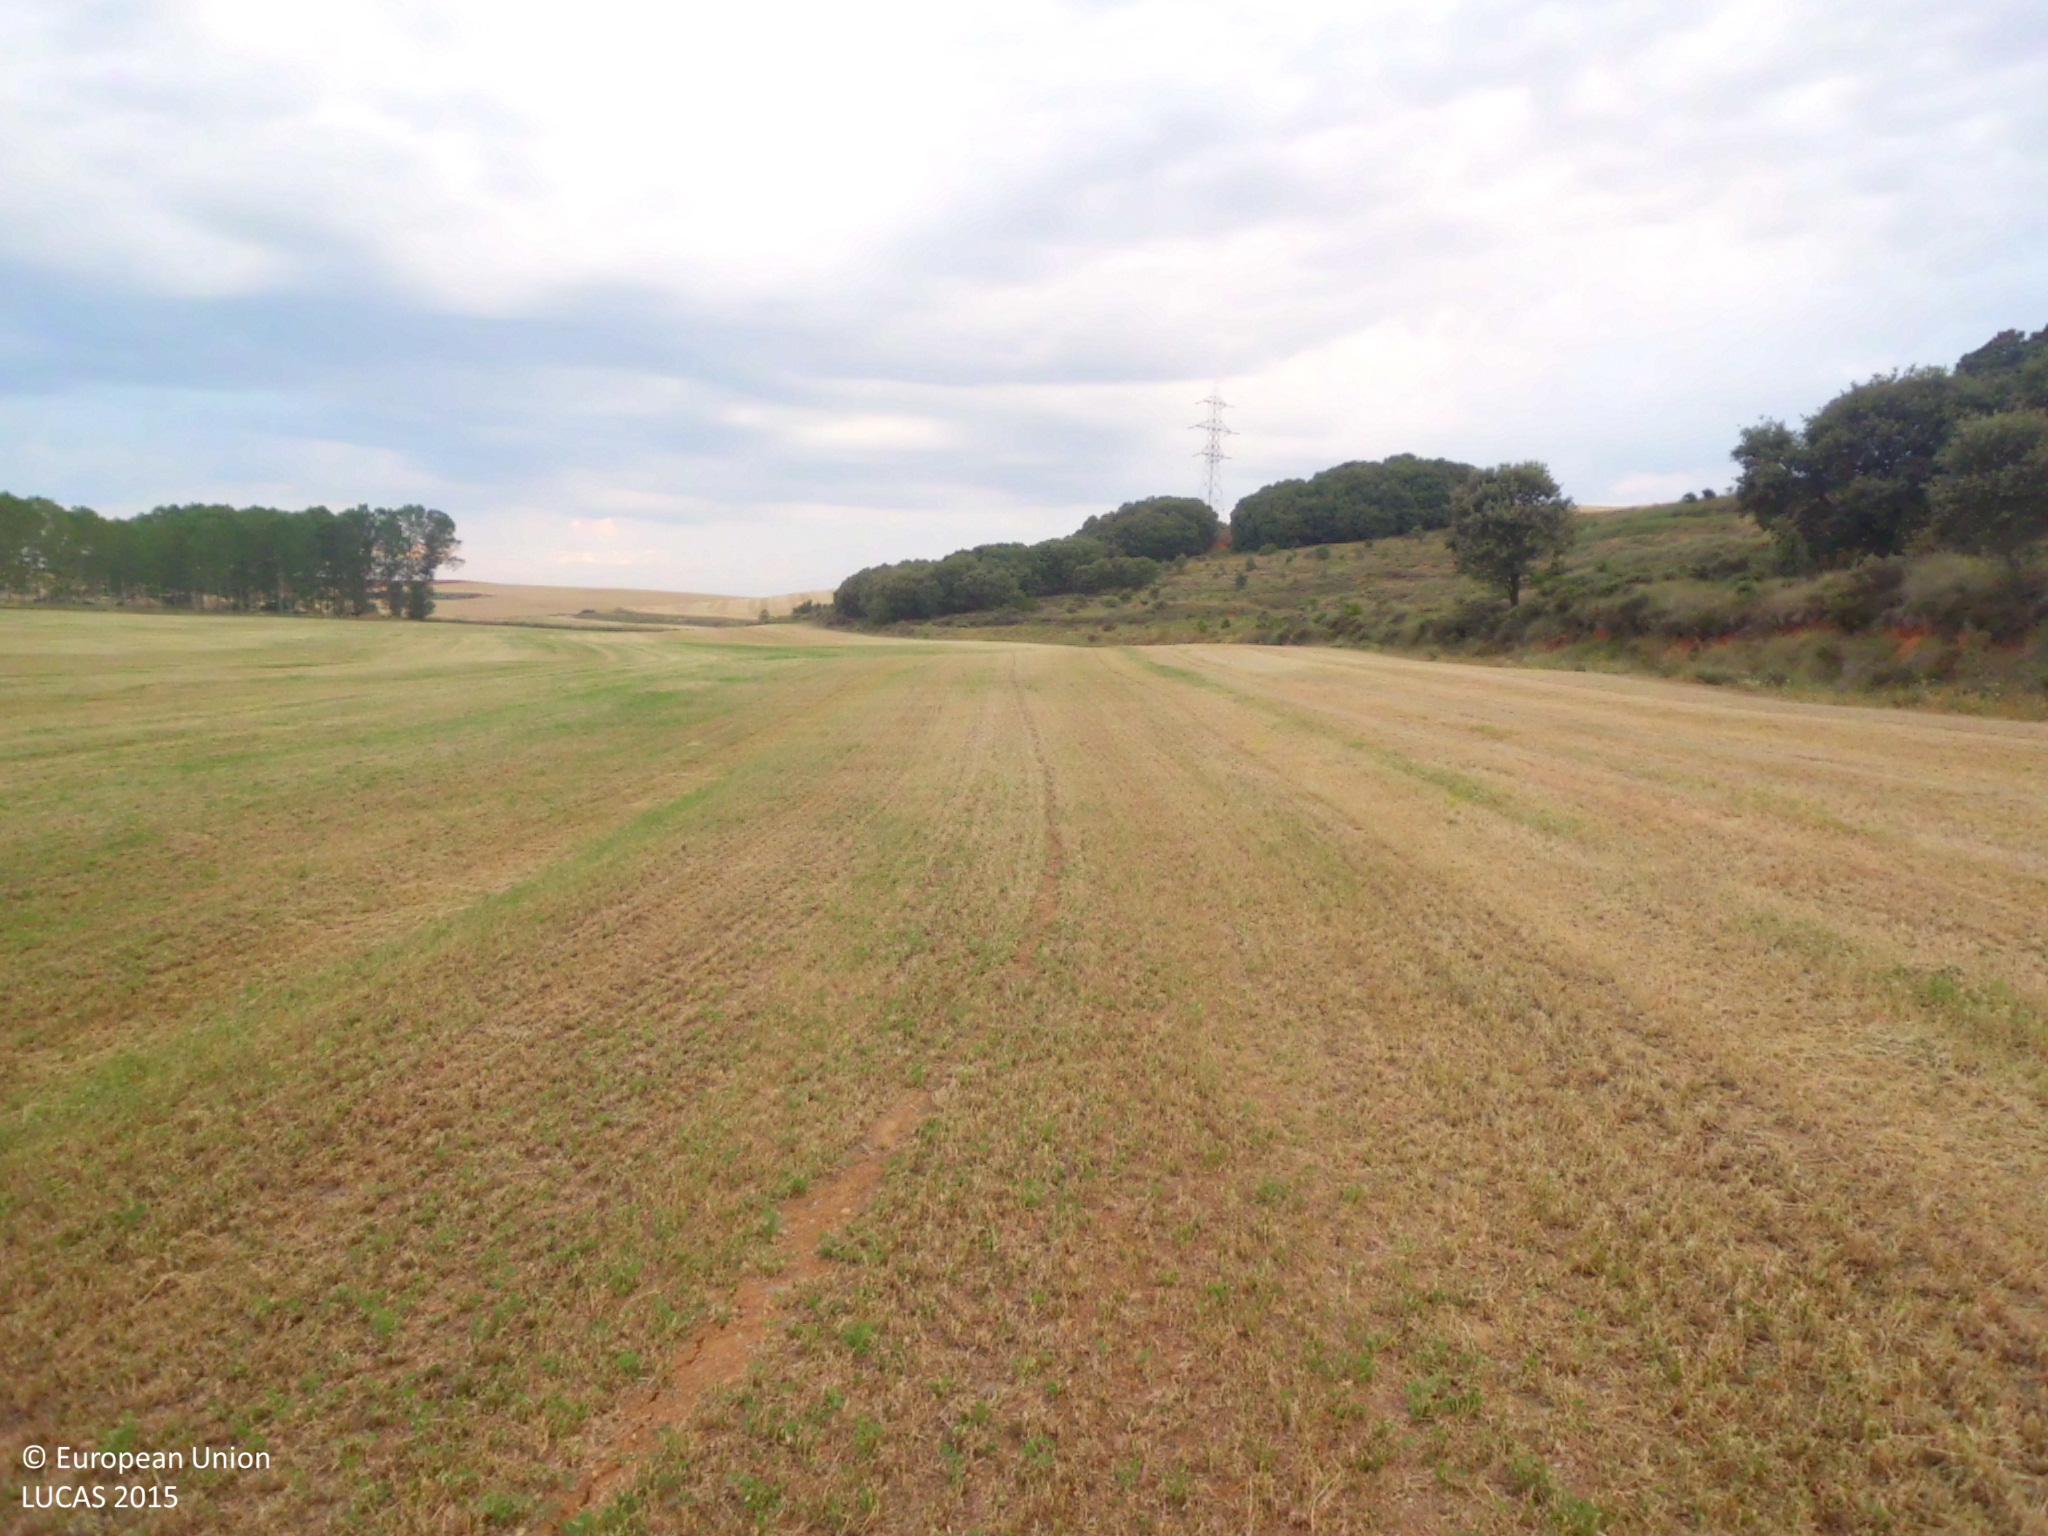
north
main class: Cropland
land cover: Lucerne
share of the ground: < 10 %
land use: Agriculture (excluding fallow land and kitchen gardens)
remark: Harvested field
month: July
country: ES
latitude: 42.6224
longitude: -4.4259
